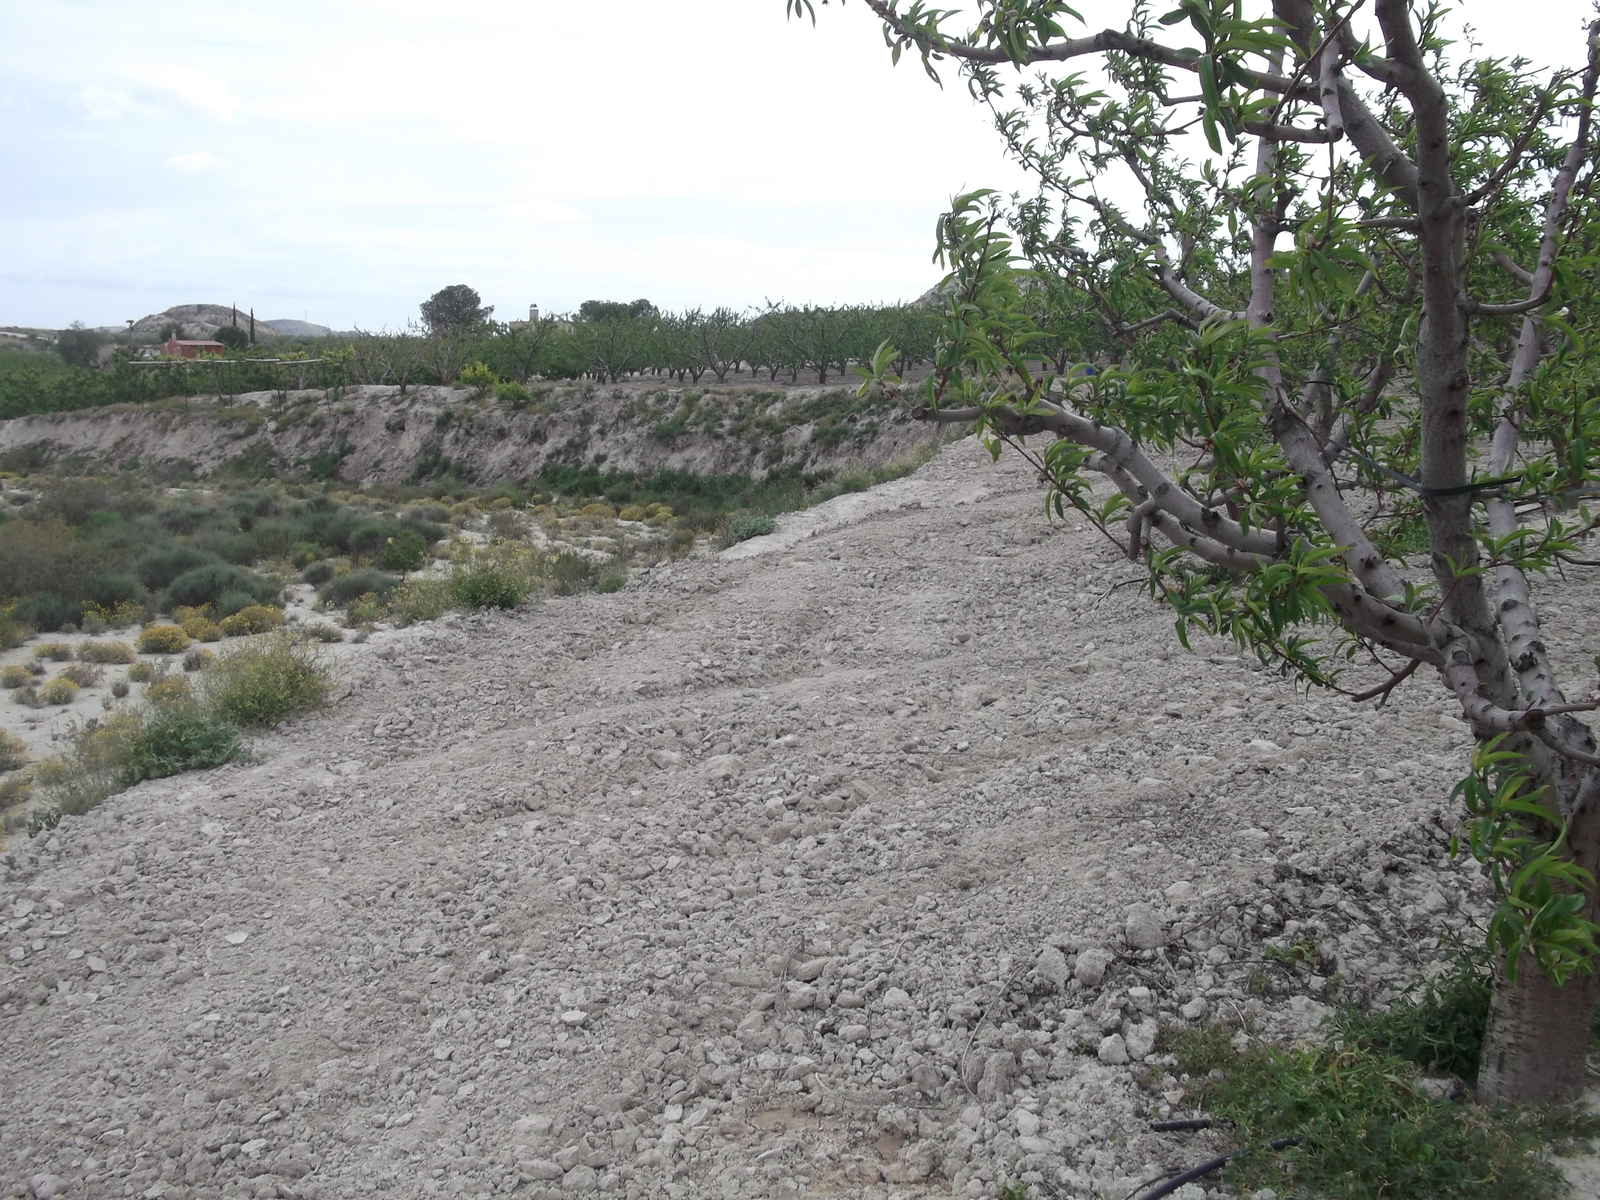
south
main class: Cropland
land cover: Nuts trees
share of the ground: 10 - 25 %
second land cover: Other bare soil
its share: > 75 %
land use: Agriculture (excluding fallow land and kitchen gardens)
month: April
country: ES
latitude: 38.0511
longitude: -1.3703
